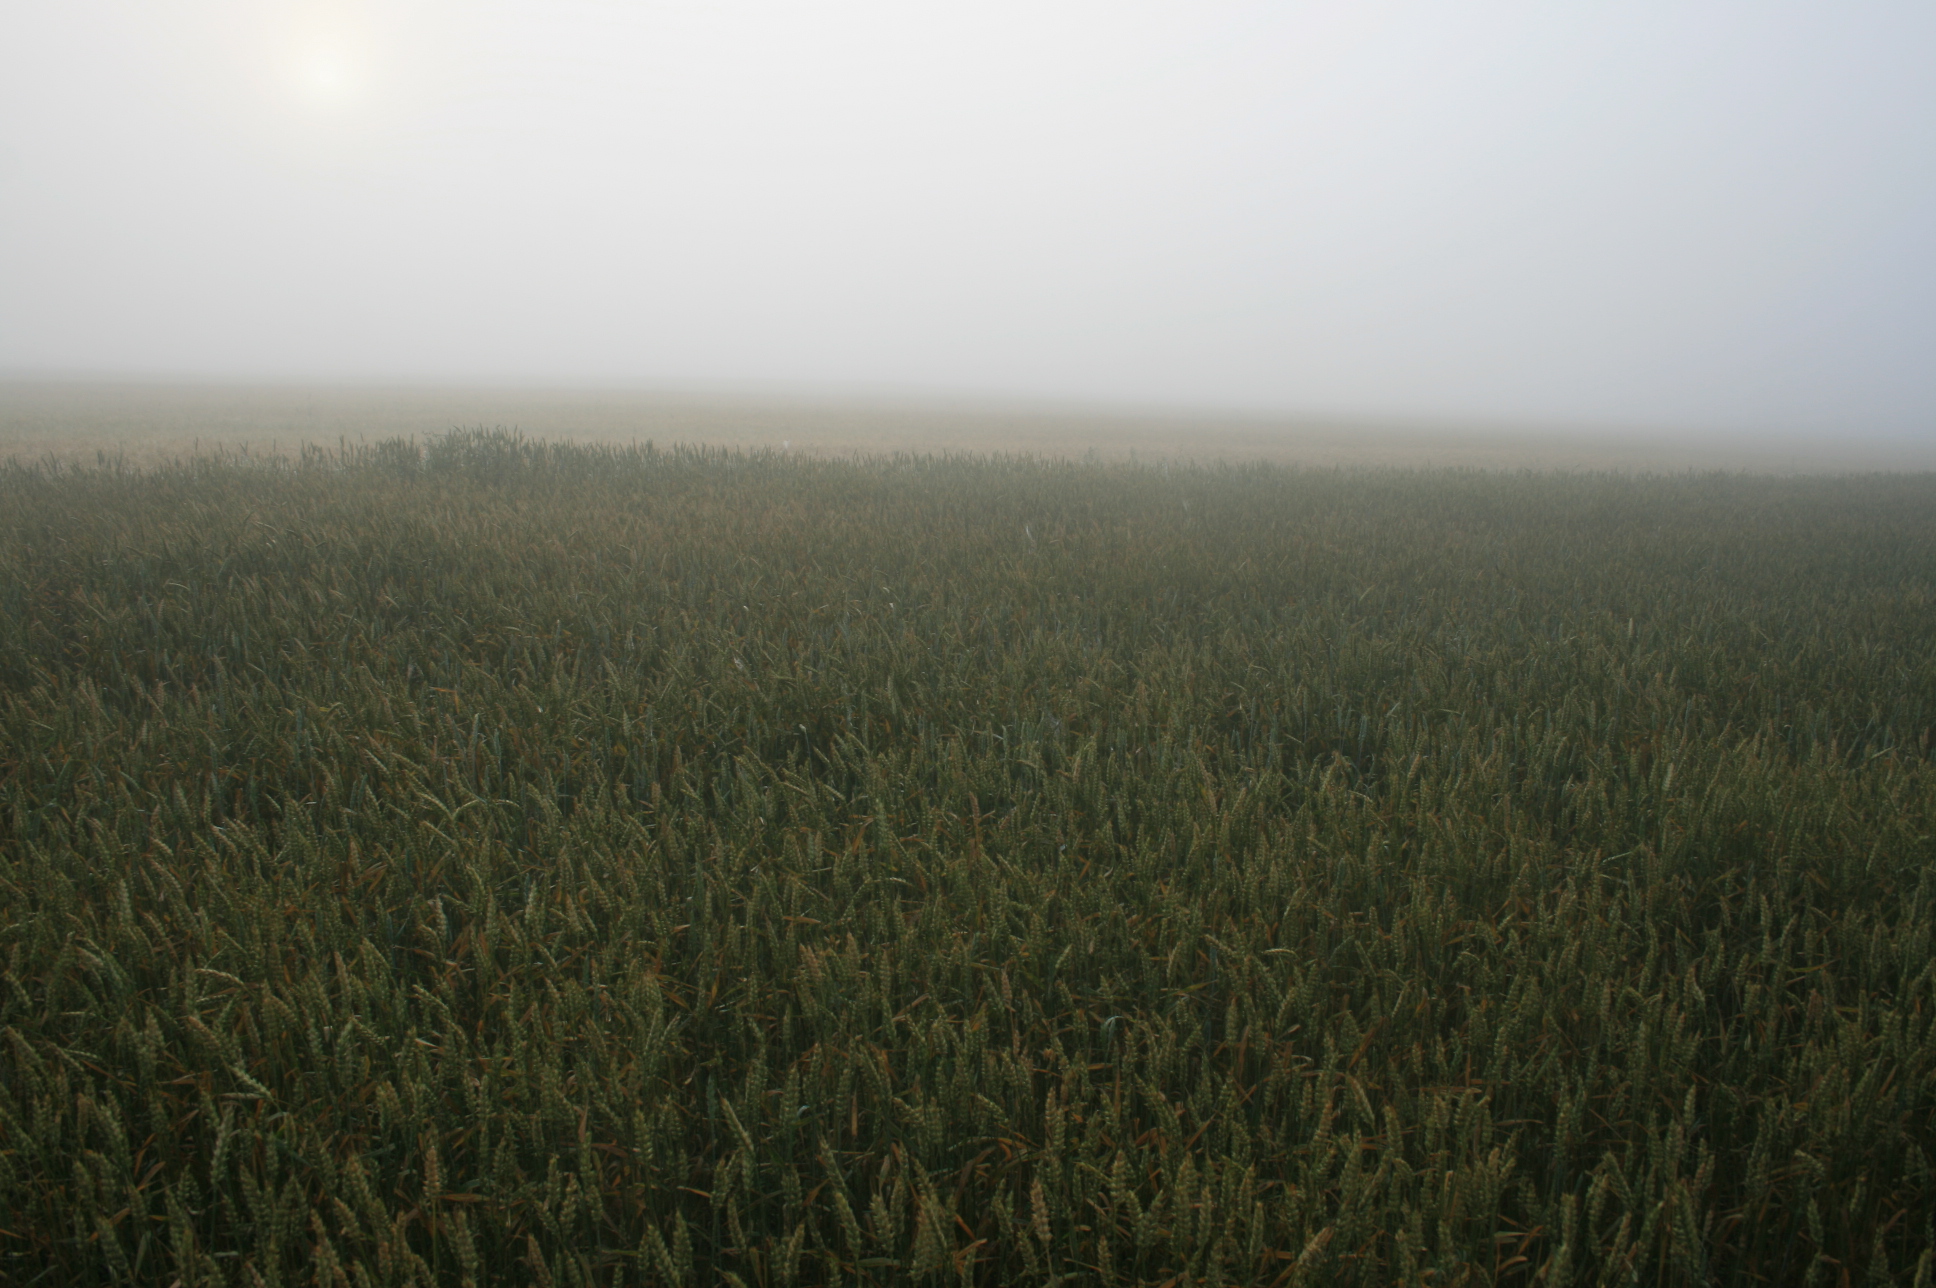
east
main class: Cropland
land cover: Common wheat
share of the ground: > 75 %
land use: Agriculture (excluding fallow land and kitchen gardens)
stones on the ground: < 10 %
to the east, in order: Common wheat; Spontaneously vegetated surfaces; Barley; Dry pulses; Common wheat
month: August
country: LT
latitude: 55.6674
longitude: 21.3146
